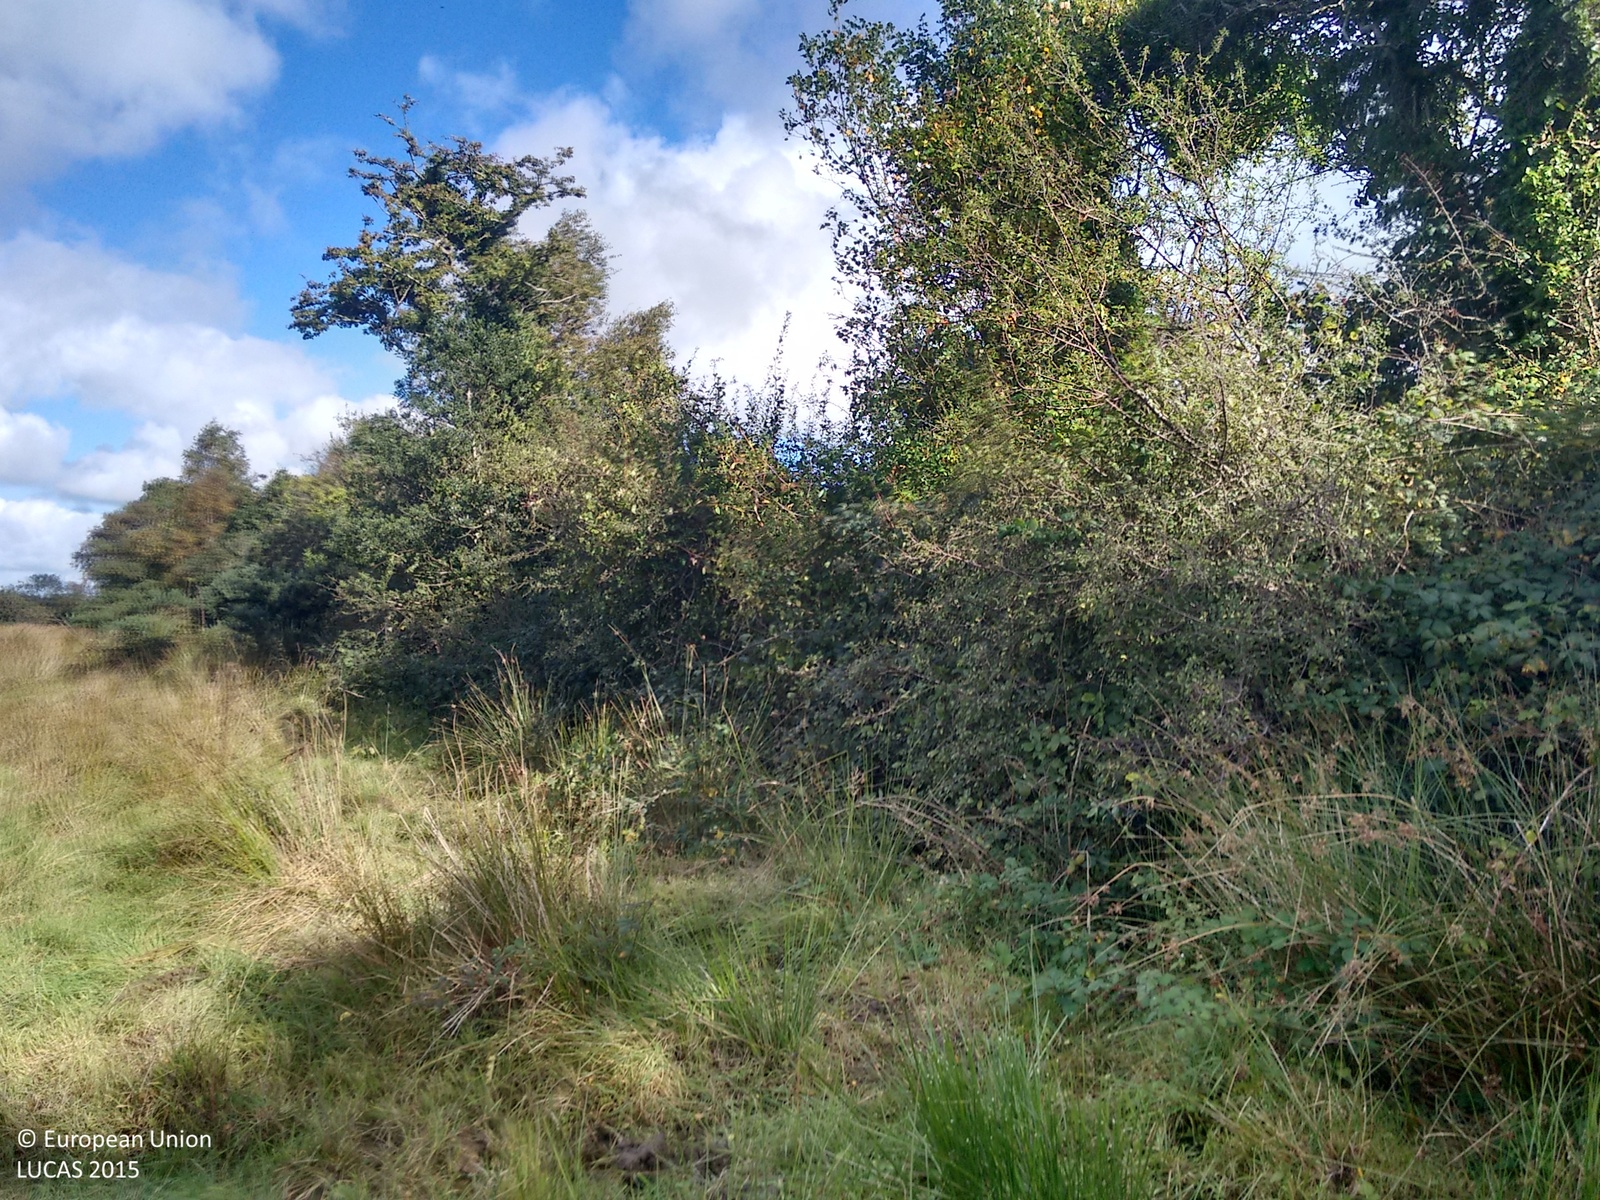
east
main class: Grassland
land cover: Grassland without tree/shrub cover
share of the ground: > 75 %
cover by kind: herbaceous plants 95 %, shrubs 5 %
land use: Agriculture (excluding fallow land and kitchen gardens)
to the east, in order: Grassland without tree/shrub cover; Shrubland without tree cover; Grassland without tree/shrub cover; Abandoned hedges
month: September
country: IE
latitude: 52.4823
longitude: -9.4776
